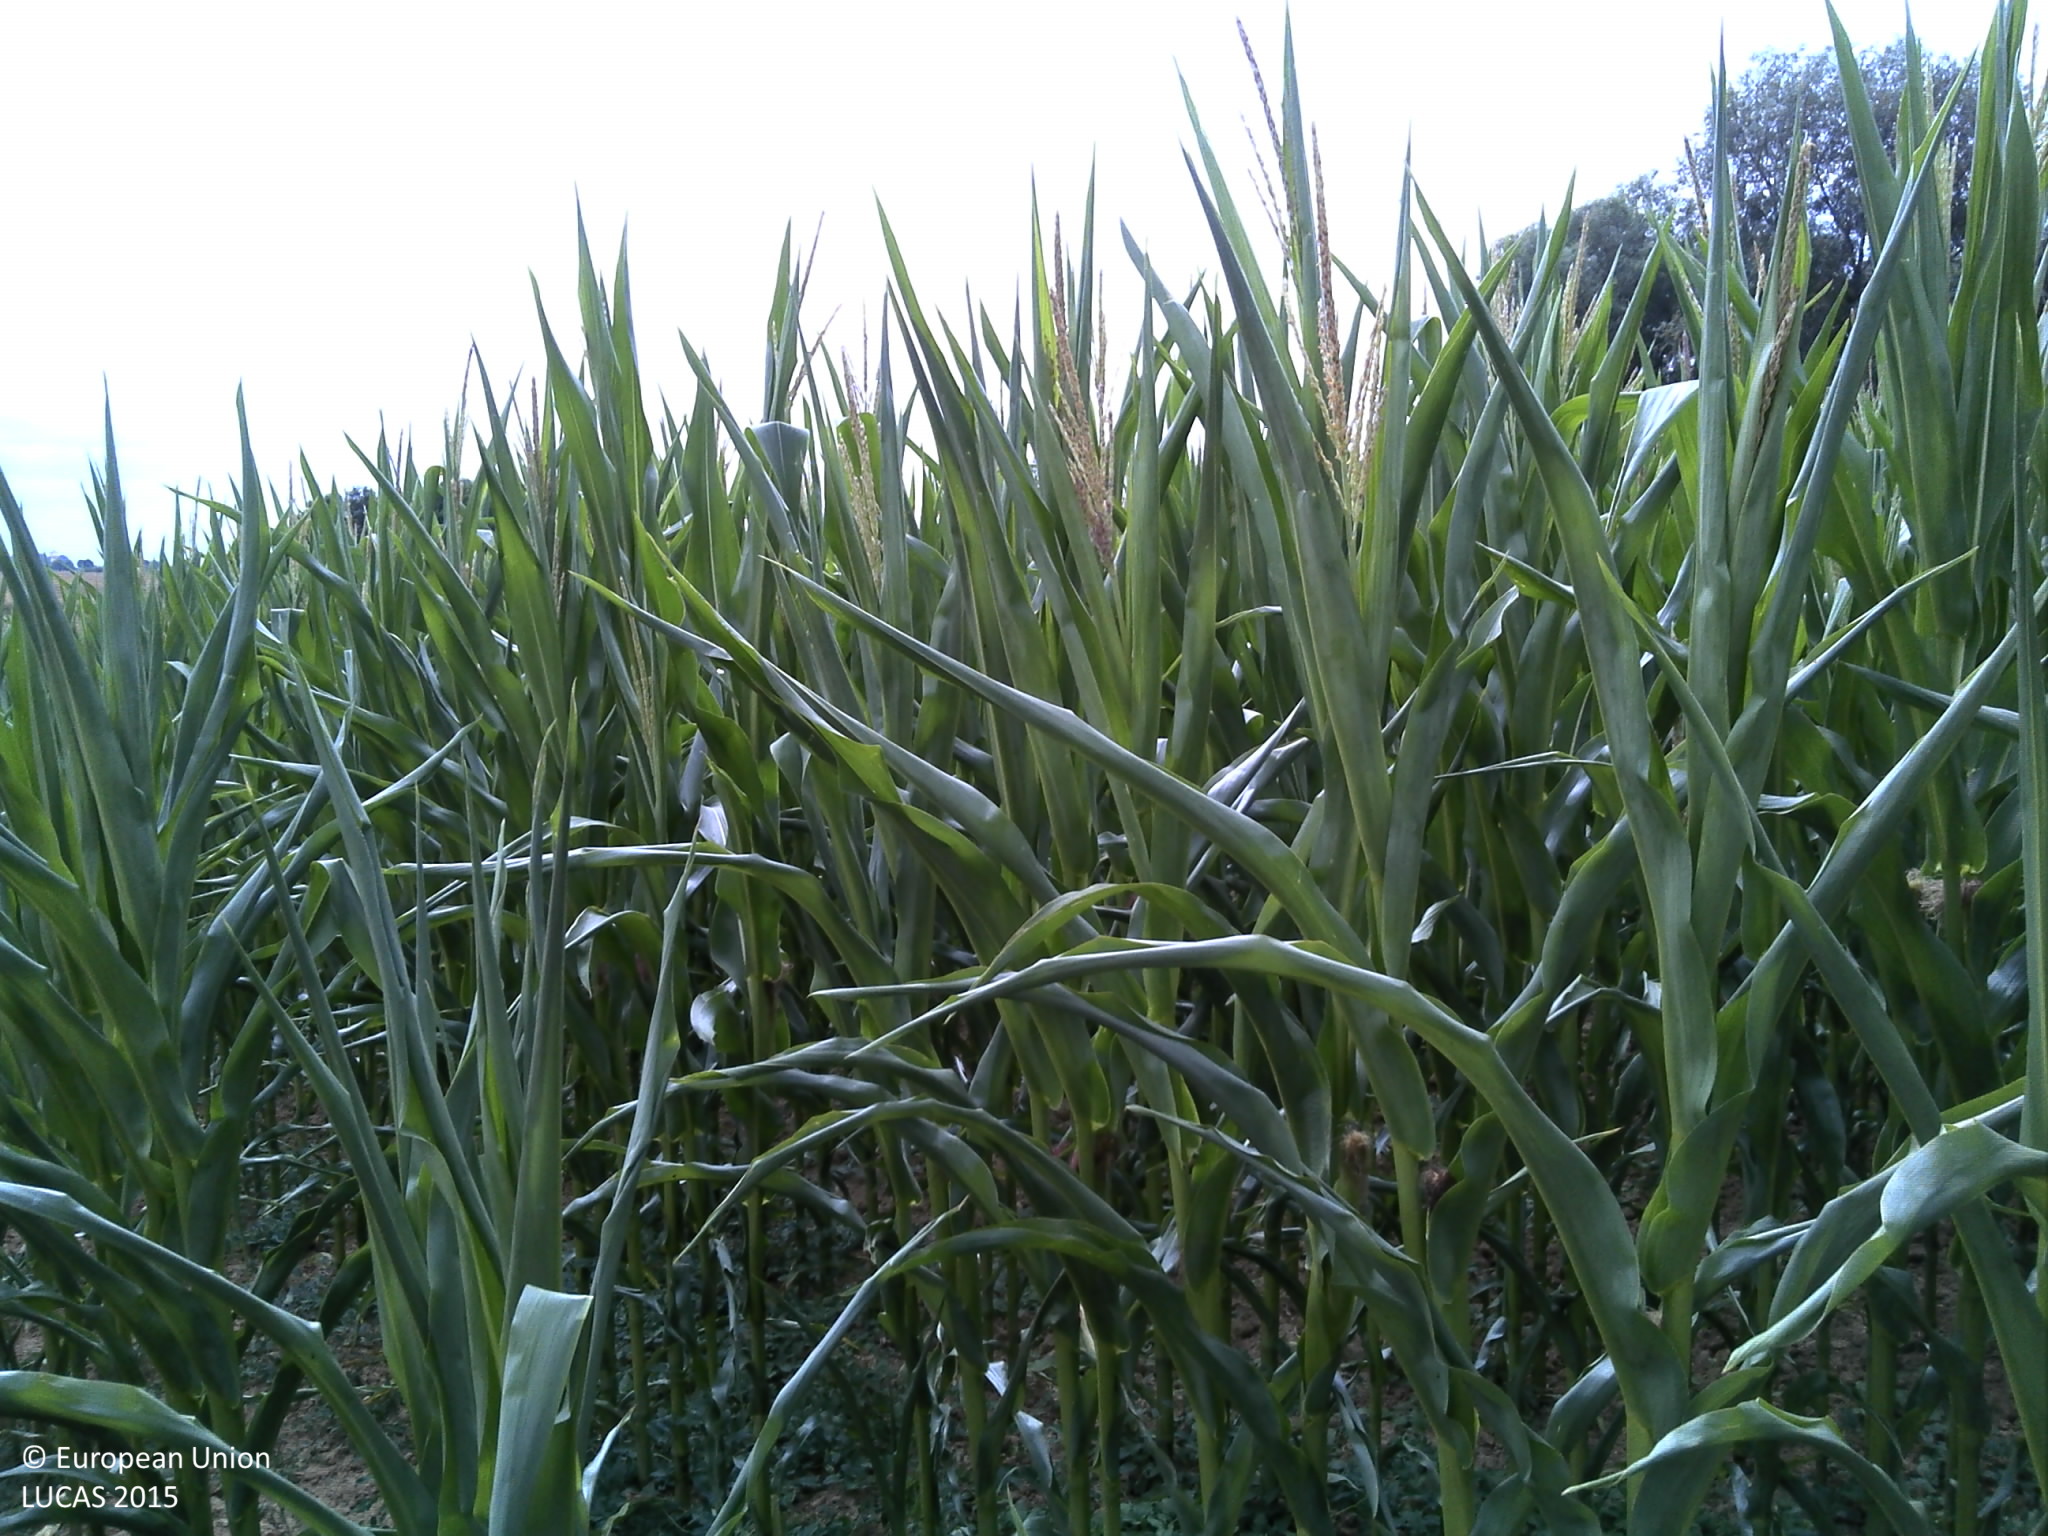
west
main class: Cropland
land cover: Rape and turnip rape
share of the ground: > 75 %
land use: Agriculture (excluding fallow land and kitchen gardens)
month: July
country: FR
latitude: 48.9889
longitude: 4.9003
